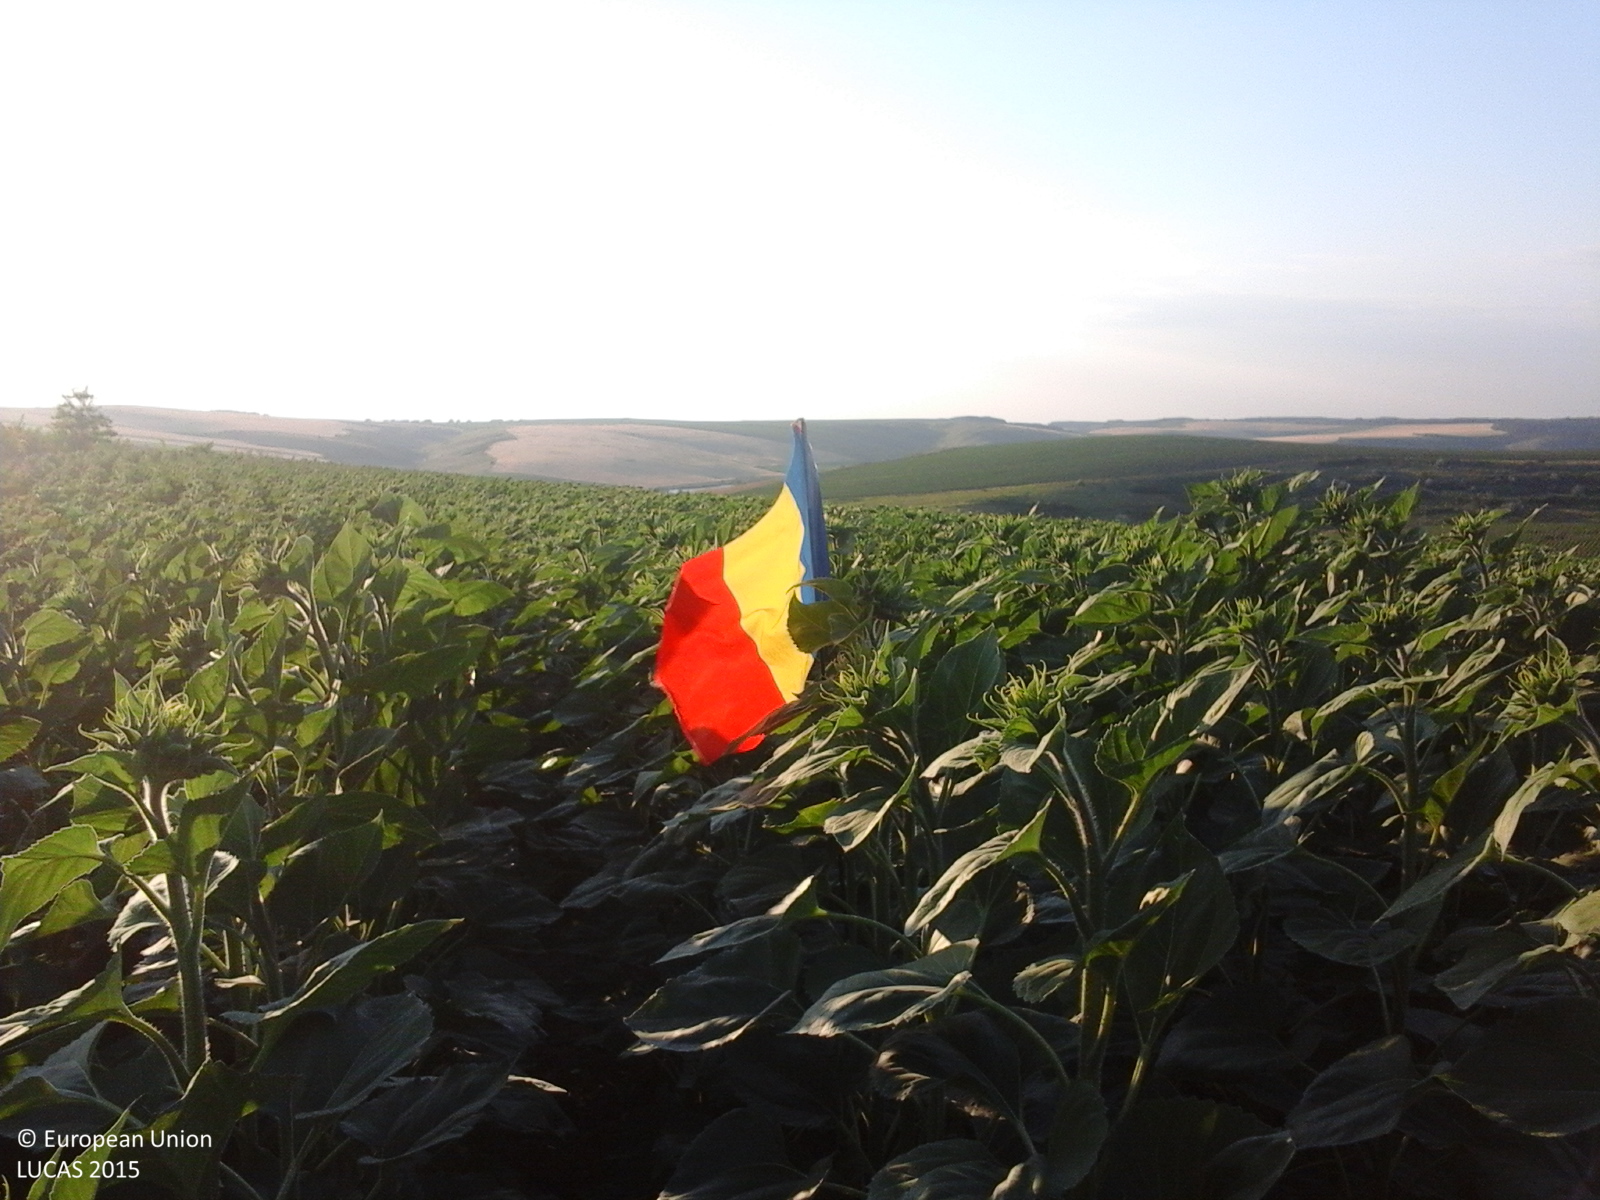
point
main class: Cropland
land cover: Sunflower
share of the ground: > 75 %
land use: Agriculture (excluding fallow land and kitchen gardens)
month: June
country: RO
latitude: 47.3952
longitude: 27.4044
